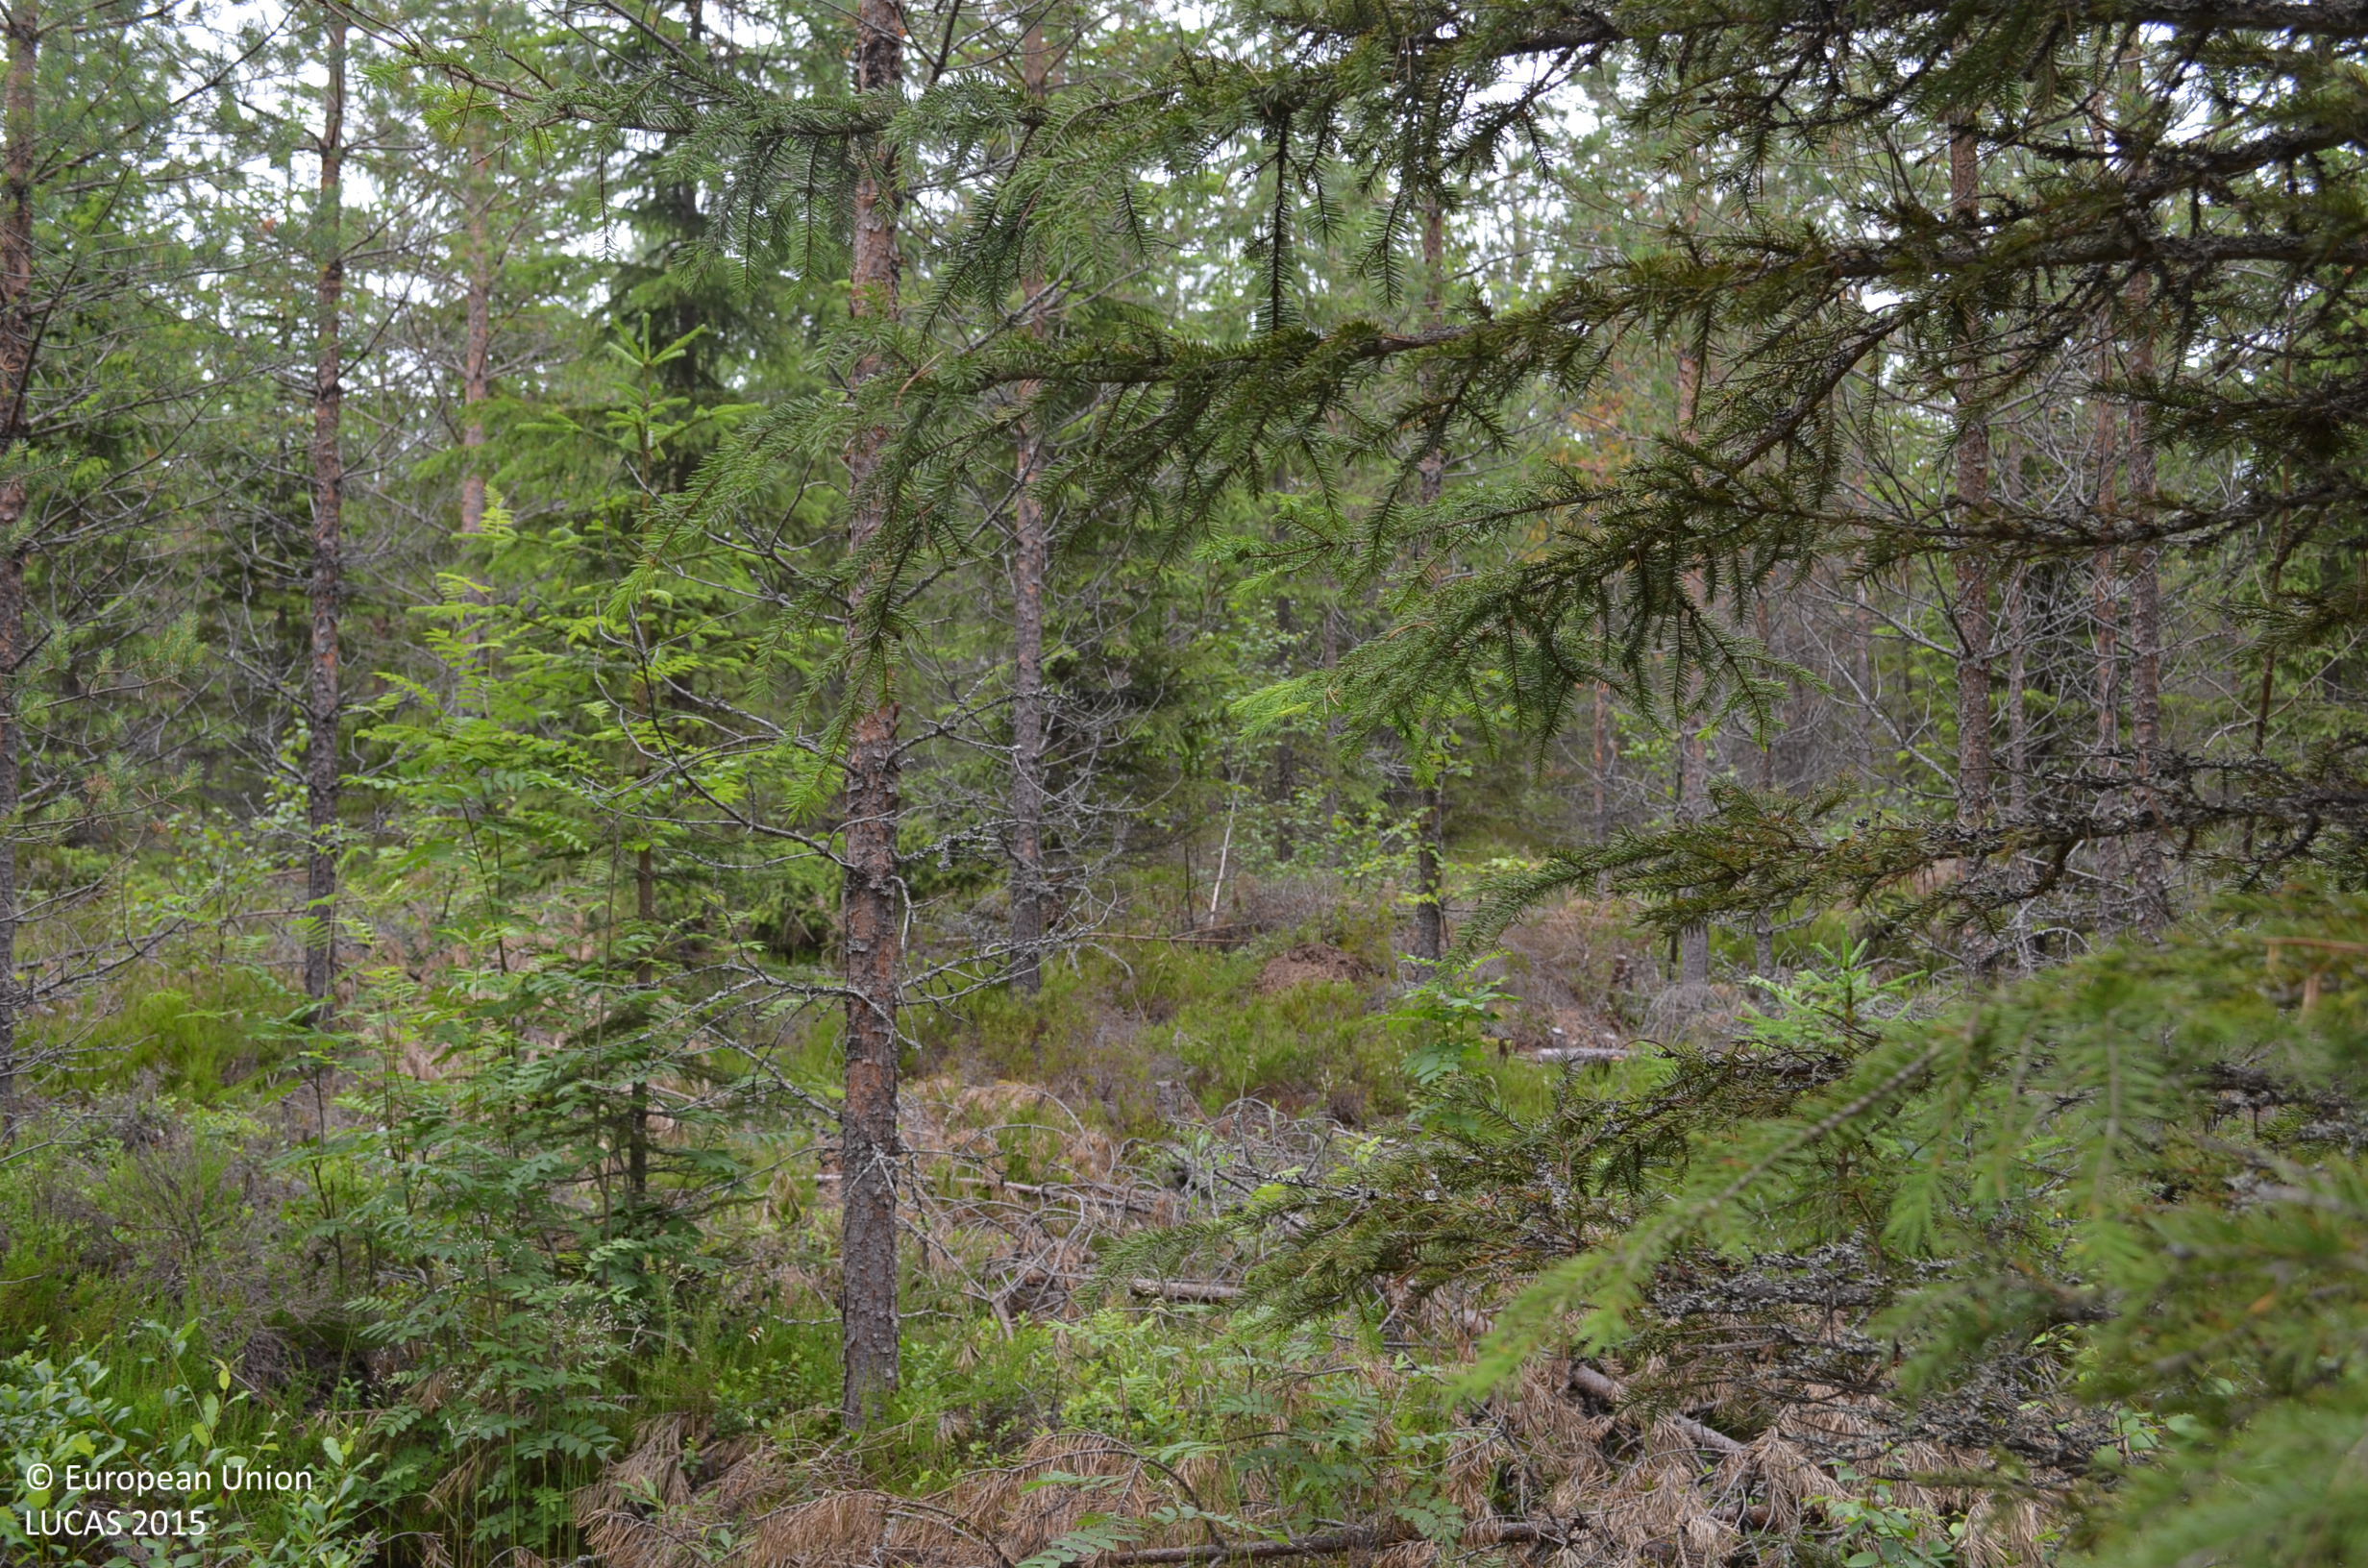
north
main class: Woodland
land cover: Other coniferous woodland
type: boreal forest
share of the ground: > 75 %
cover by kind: coniferous forest trees 80 %, shrubs 15 %
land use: Forestry
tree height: > 5 m
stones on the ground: < 10 %
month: July
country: FI
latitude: 62.2580
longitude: 23.4950
